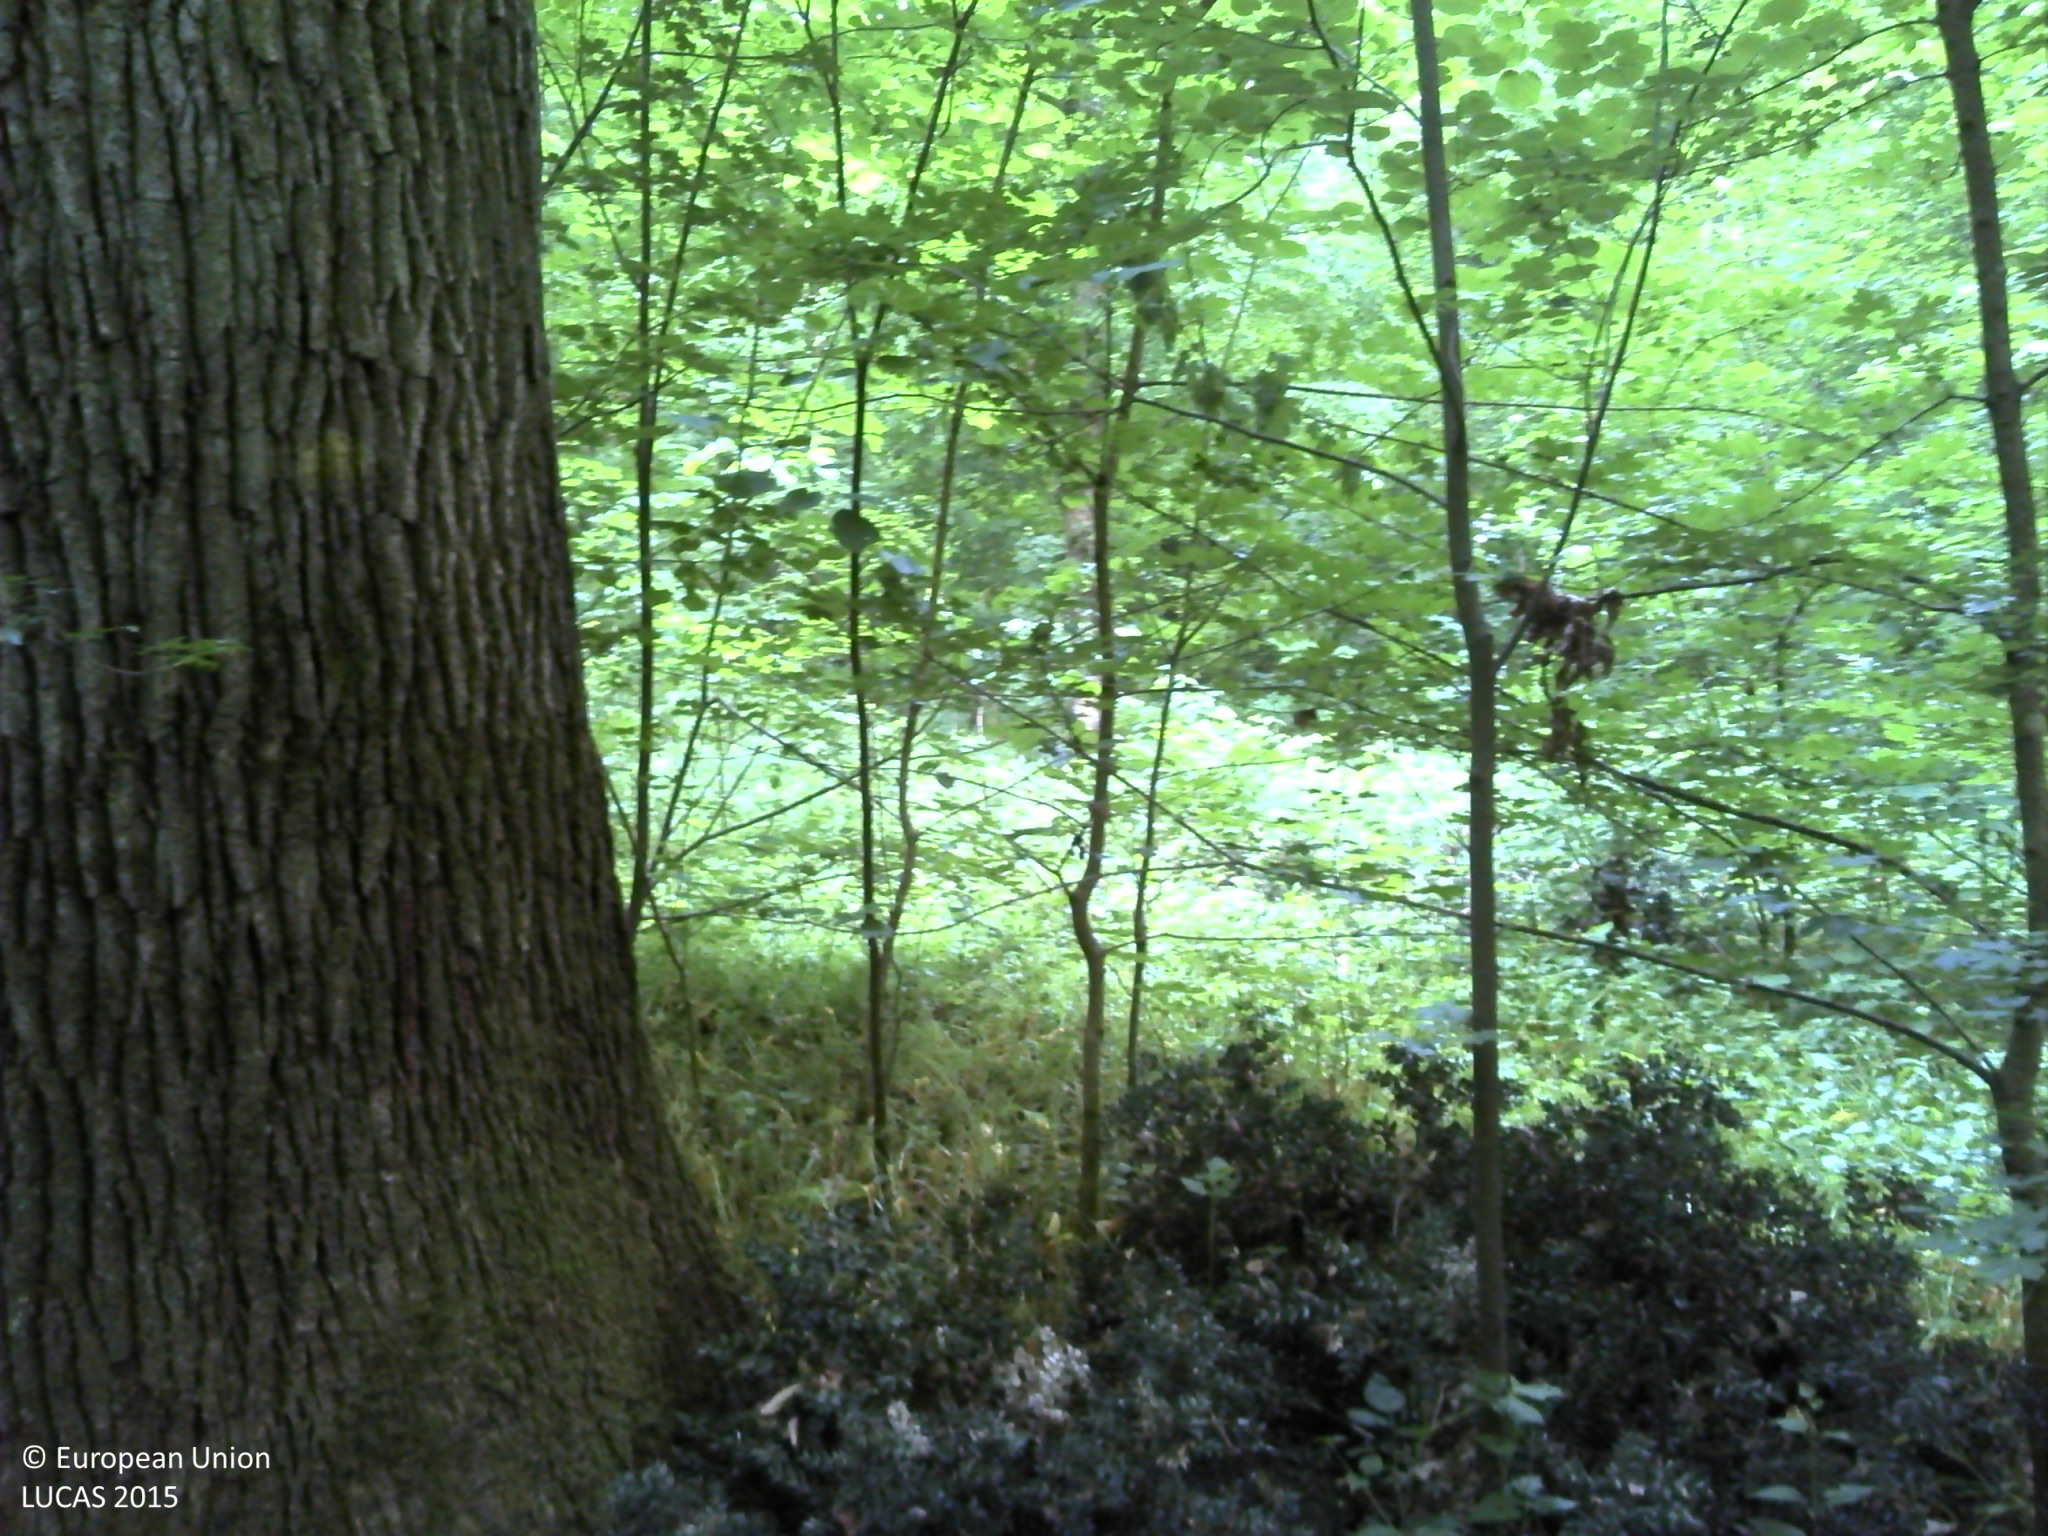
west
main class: Woodland
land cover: Broadleaved woodland
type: acidophilous oak and oak-birch forest
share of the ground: > 75 %
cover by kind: broadleaved forest trees 100 %
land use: Forestry
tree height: > 5 m
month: May
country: HR
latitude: 45.5619
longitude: 18.2431
